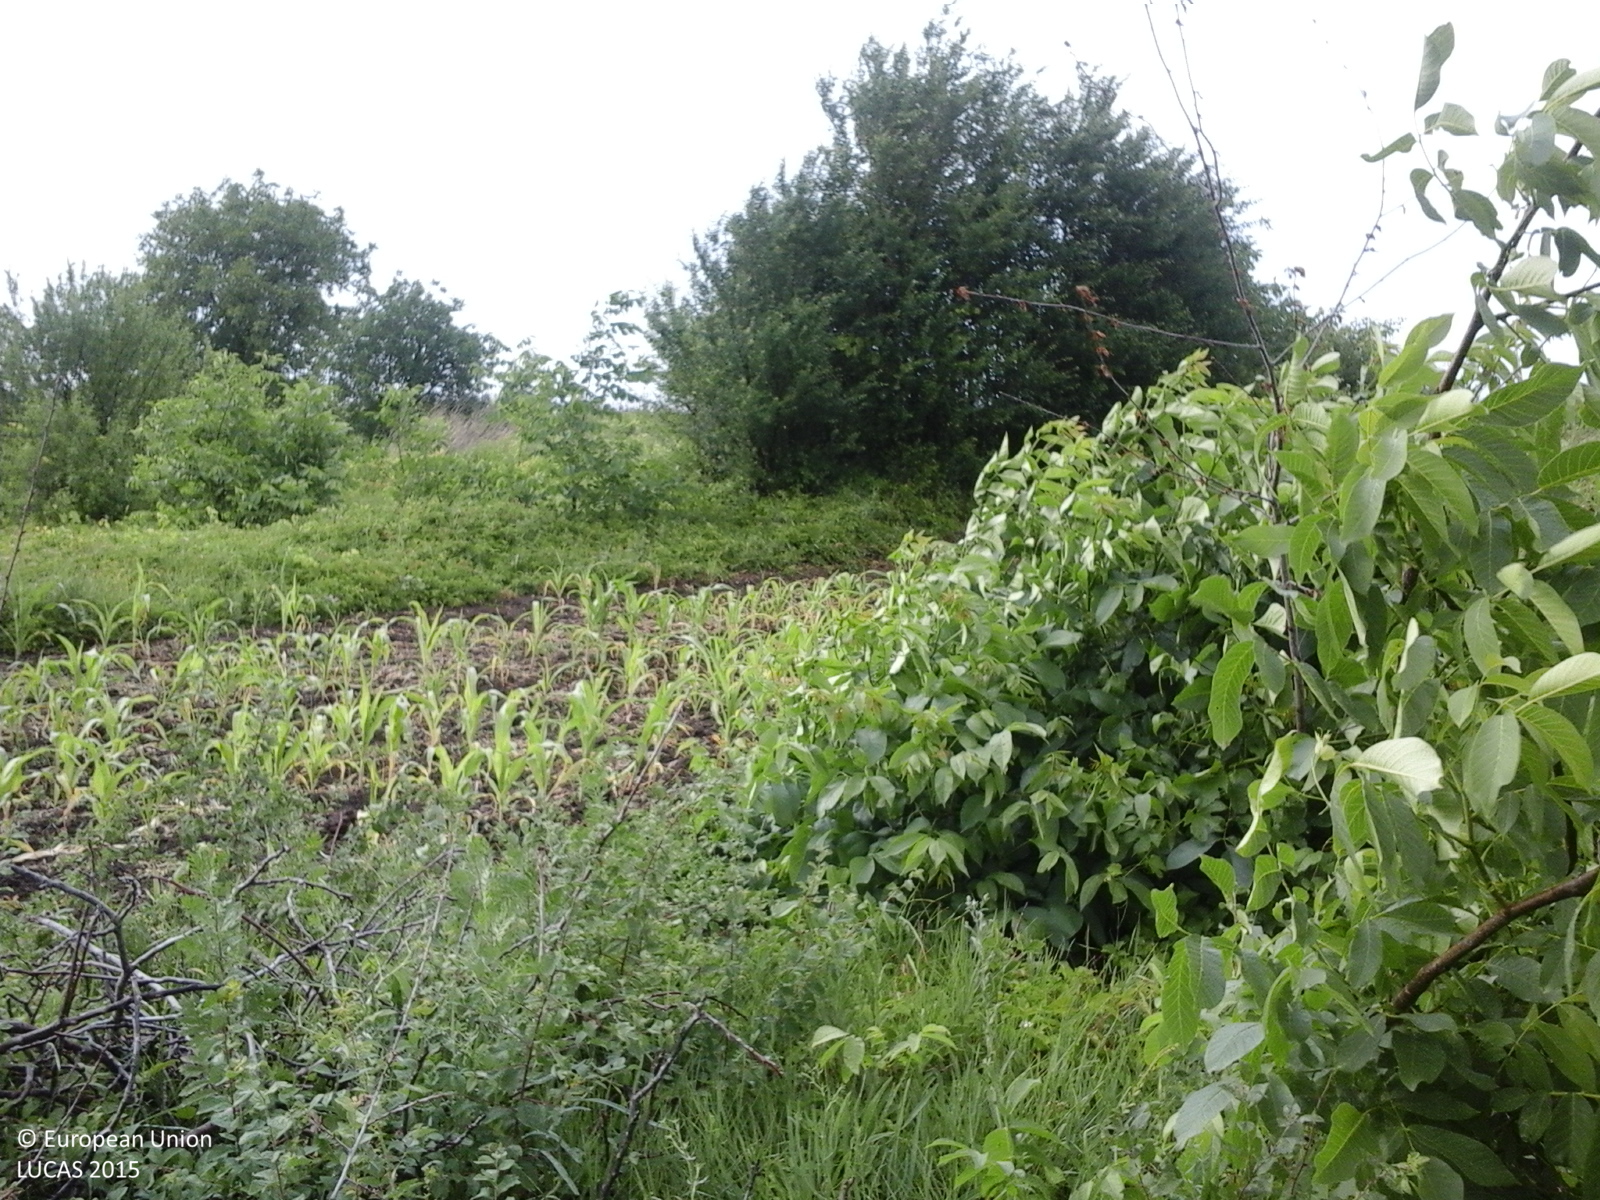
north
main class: Cropland
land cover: Vineyards
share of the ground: 50 - 75 %
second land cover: Other bare soil
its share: > 75 %
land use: Agriculture (excluding fallow land and kitchen gardens)
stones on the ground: < 10 %
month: June
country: RO
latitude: 47.6404
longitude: 27.0226
